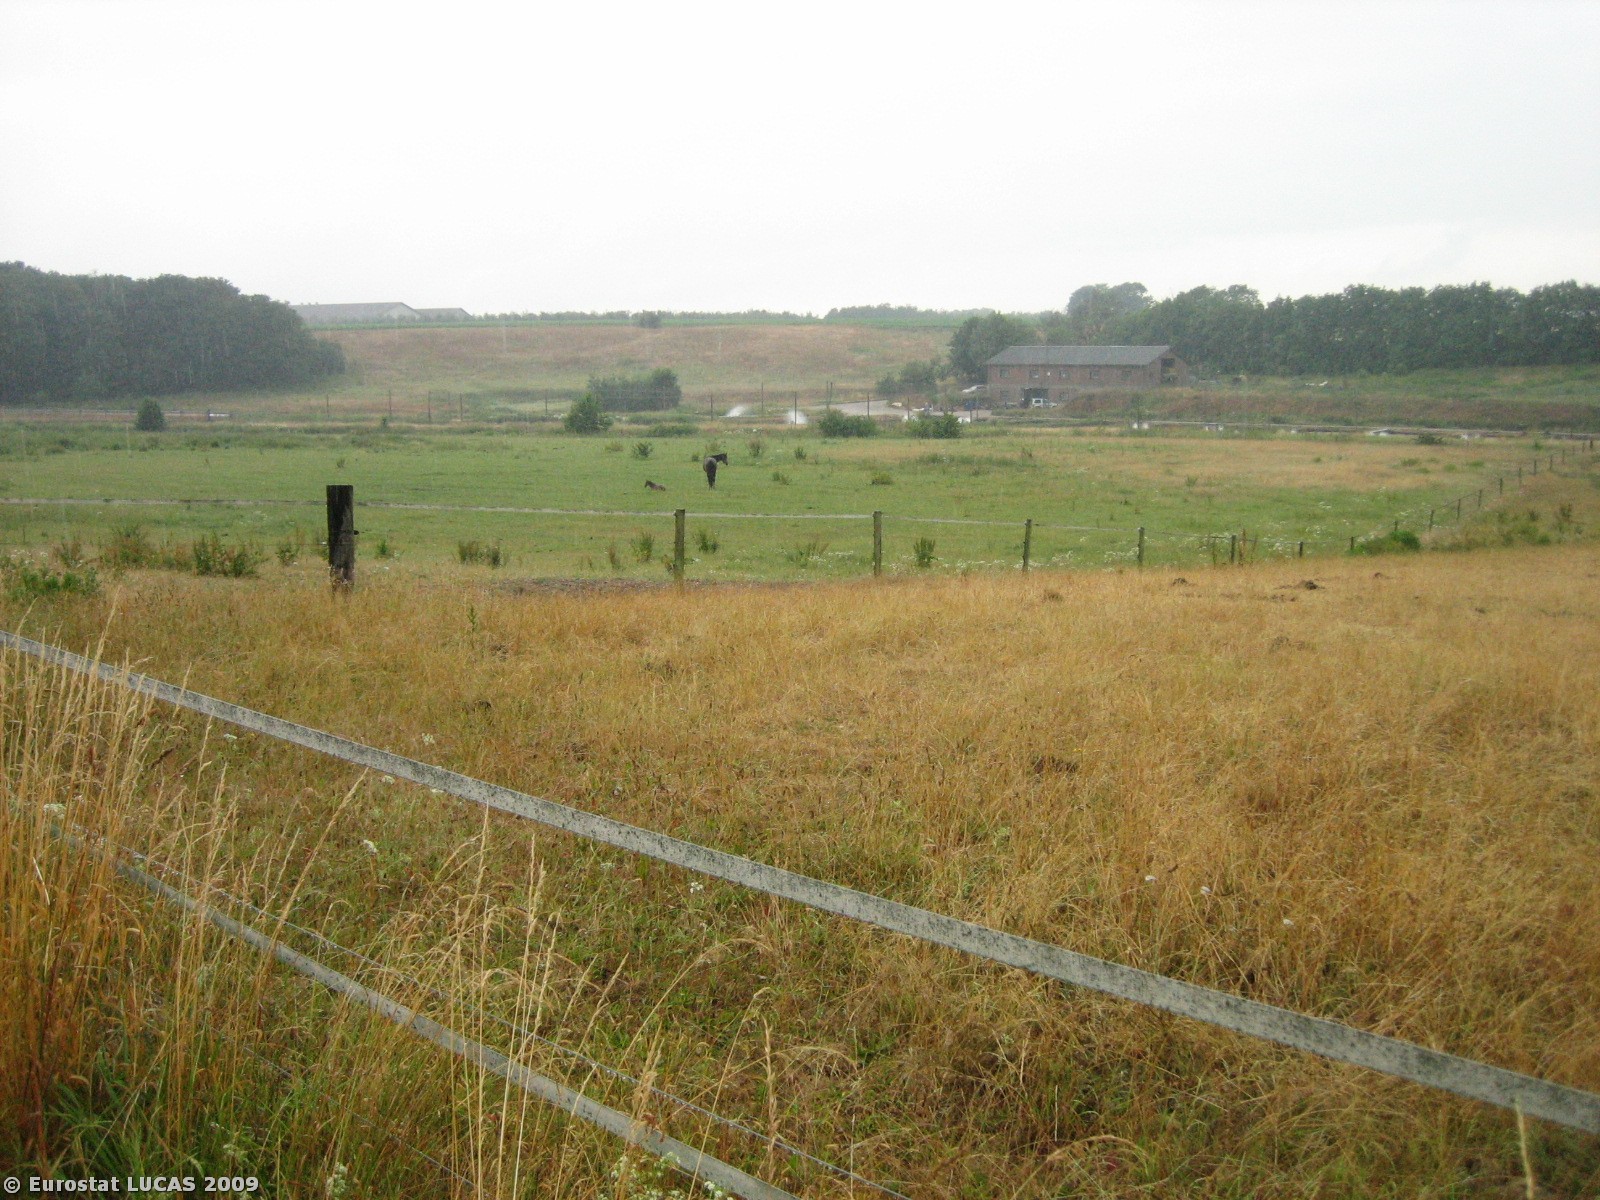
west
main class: Shrubland
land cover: Shrubland without tree cover
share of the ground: > 75 %
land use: Unused
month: July
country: DK
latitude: 55.4997
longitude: 8.8771
